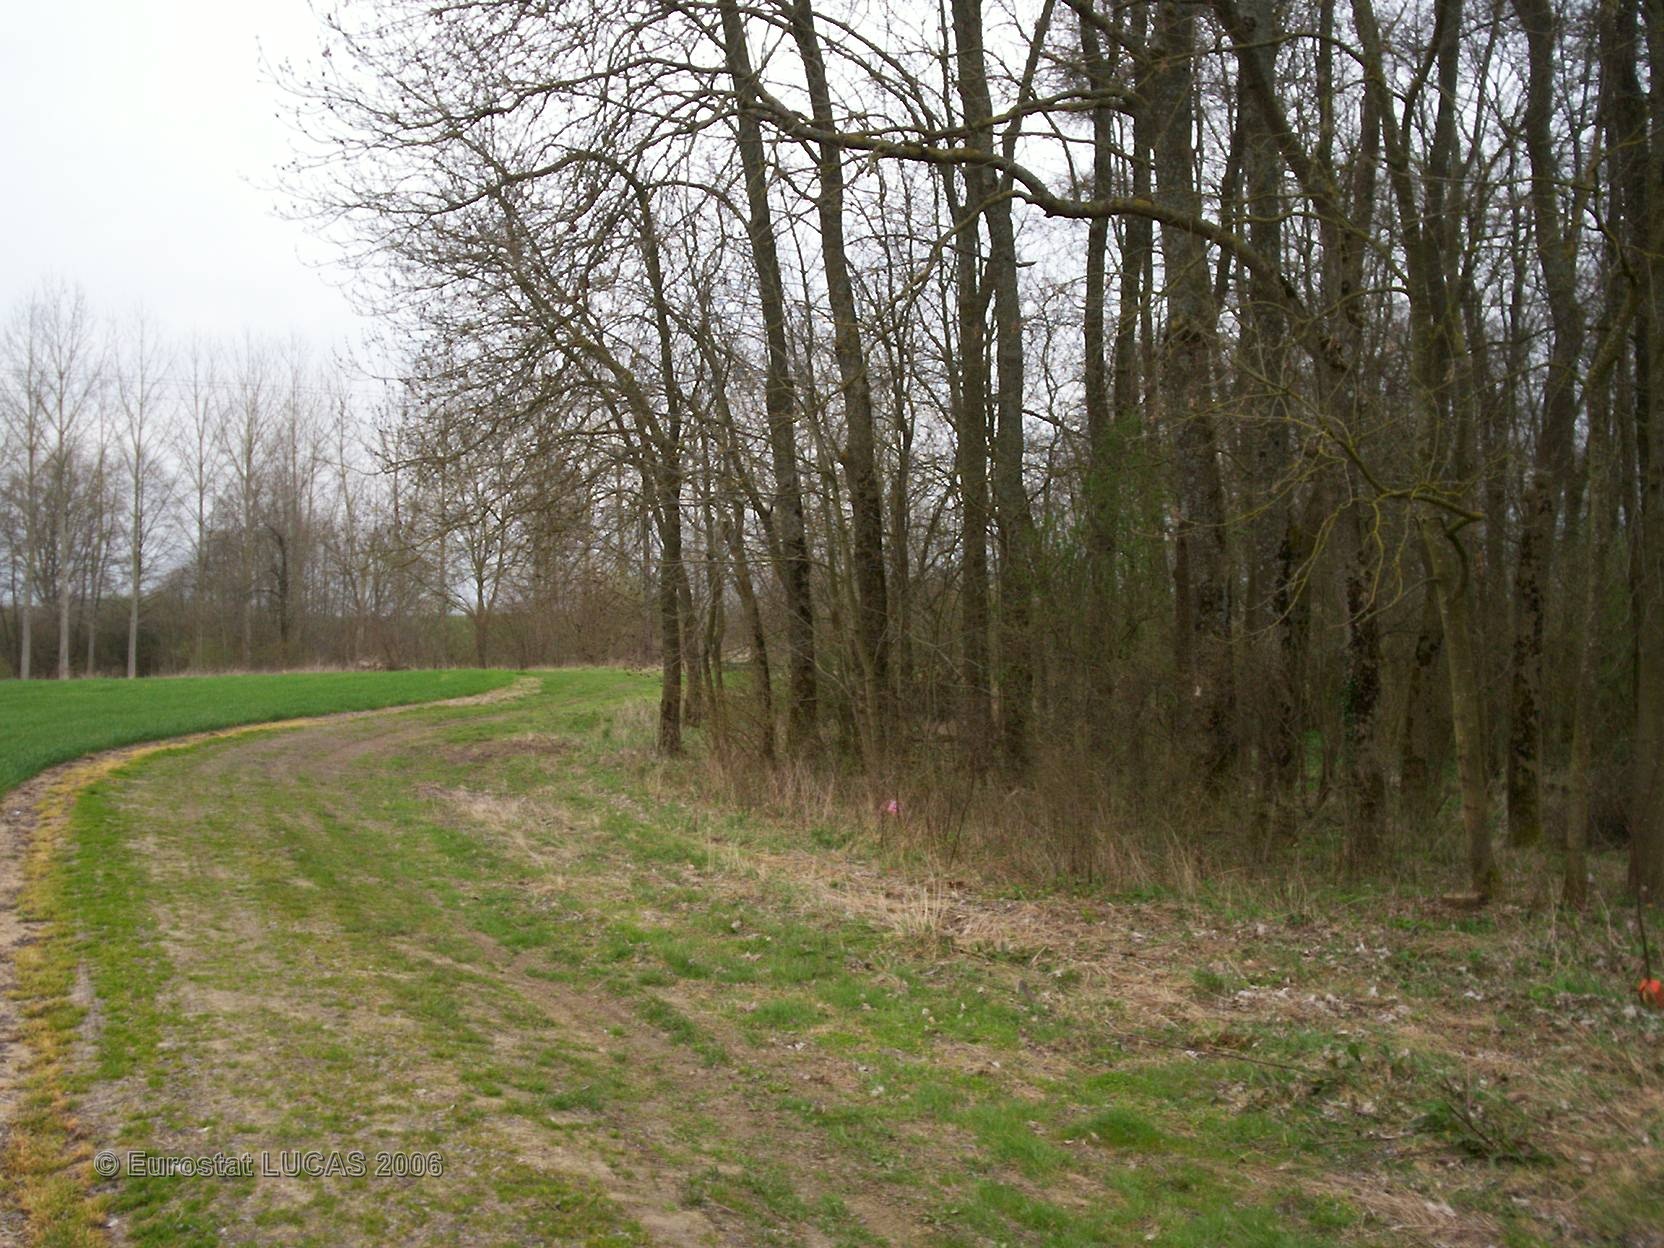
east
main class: Cropland
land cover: Common wheat
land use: Agriculture (excluding fallow land and kitchen gardens)
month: April
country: FR
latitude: 49.1833
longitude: 4.4400
